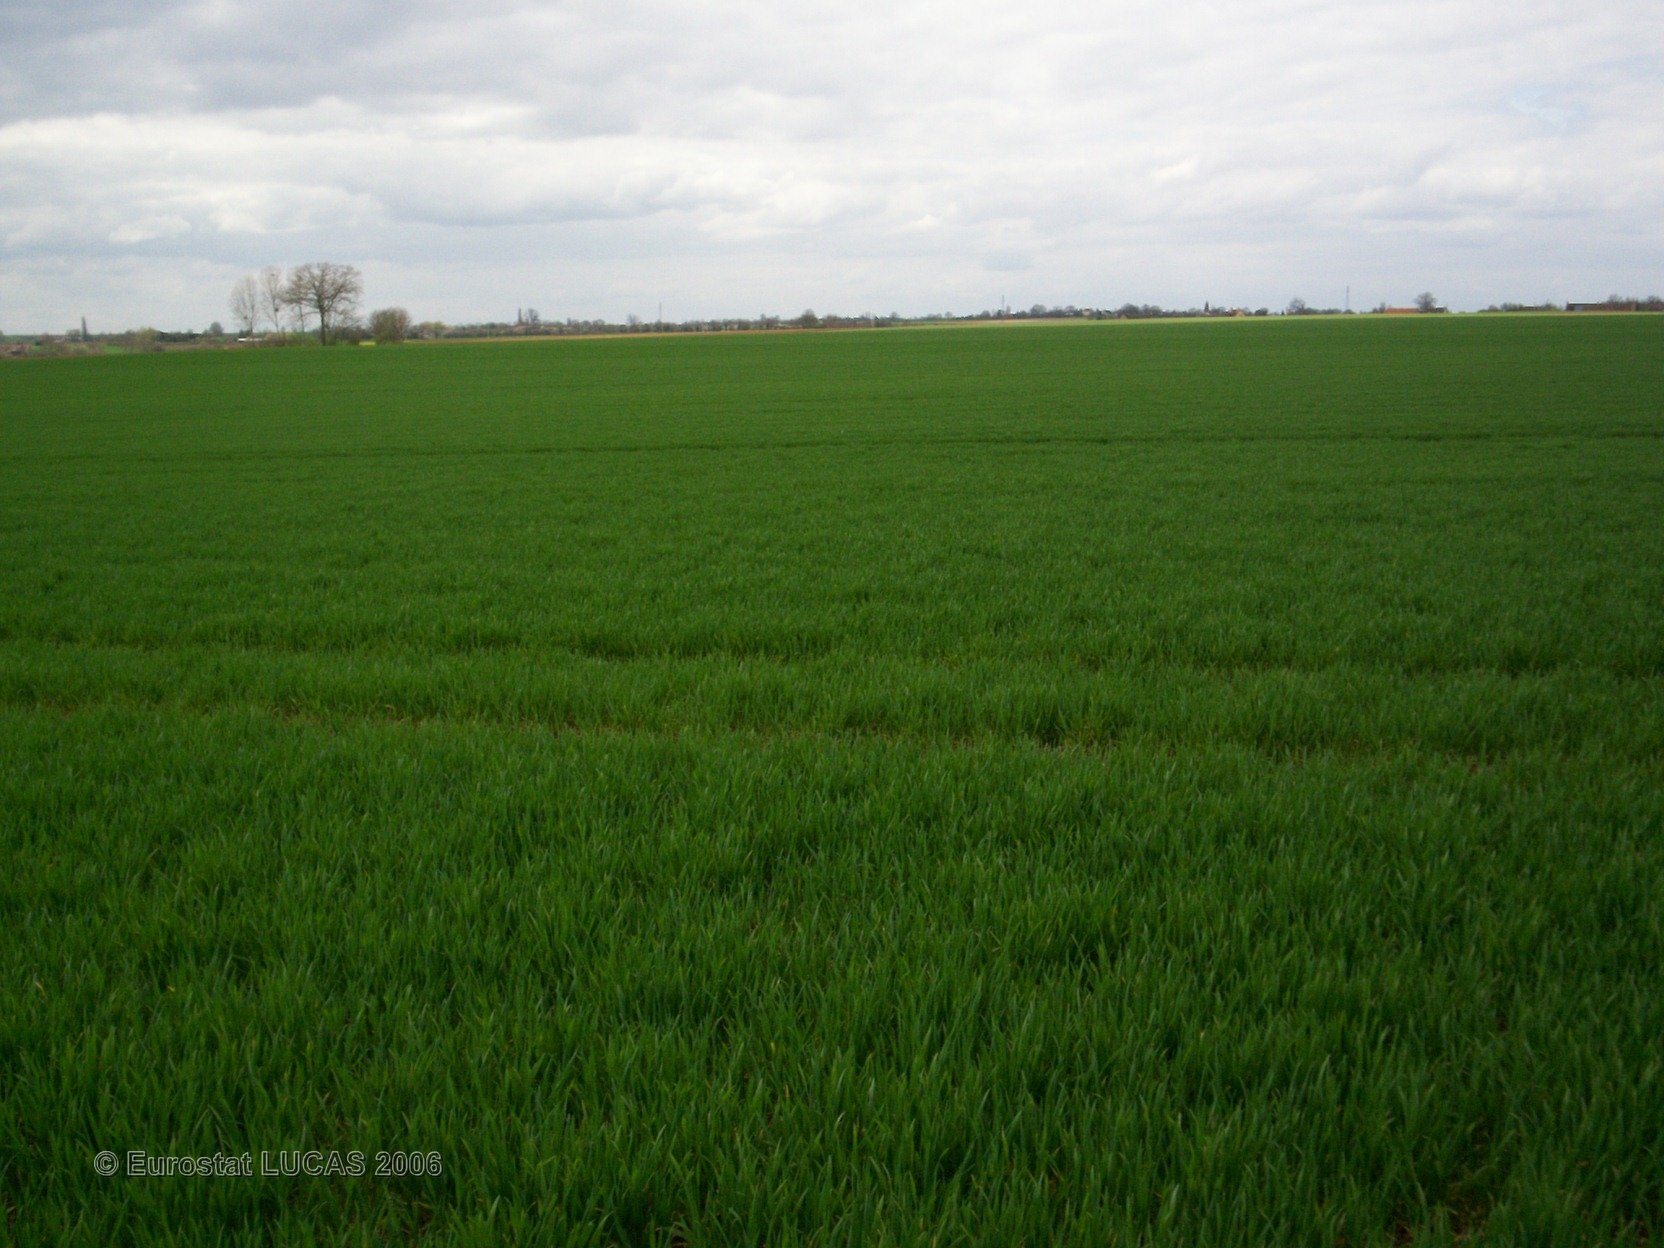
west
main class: Cropland
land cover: Common wheat
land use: Agriculture (excluding fallow land and kitchen gardens)
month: April
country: FR
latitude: 48.3053
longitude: 0.3345
